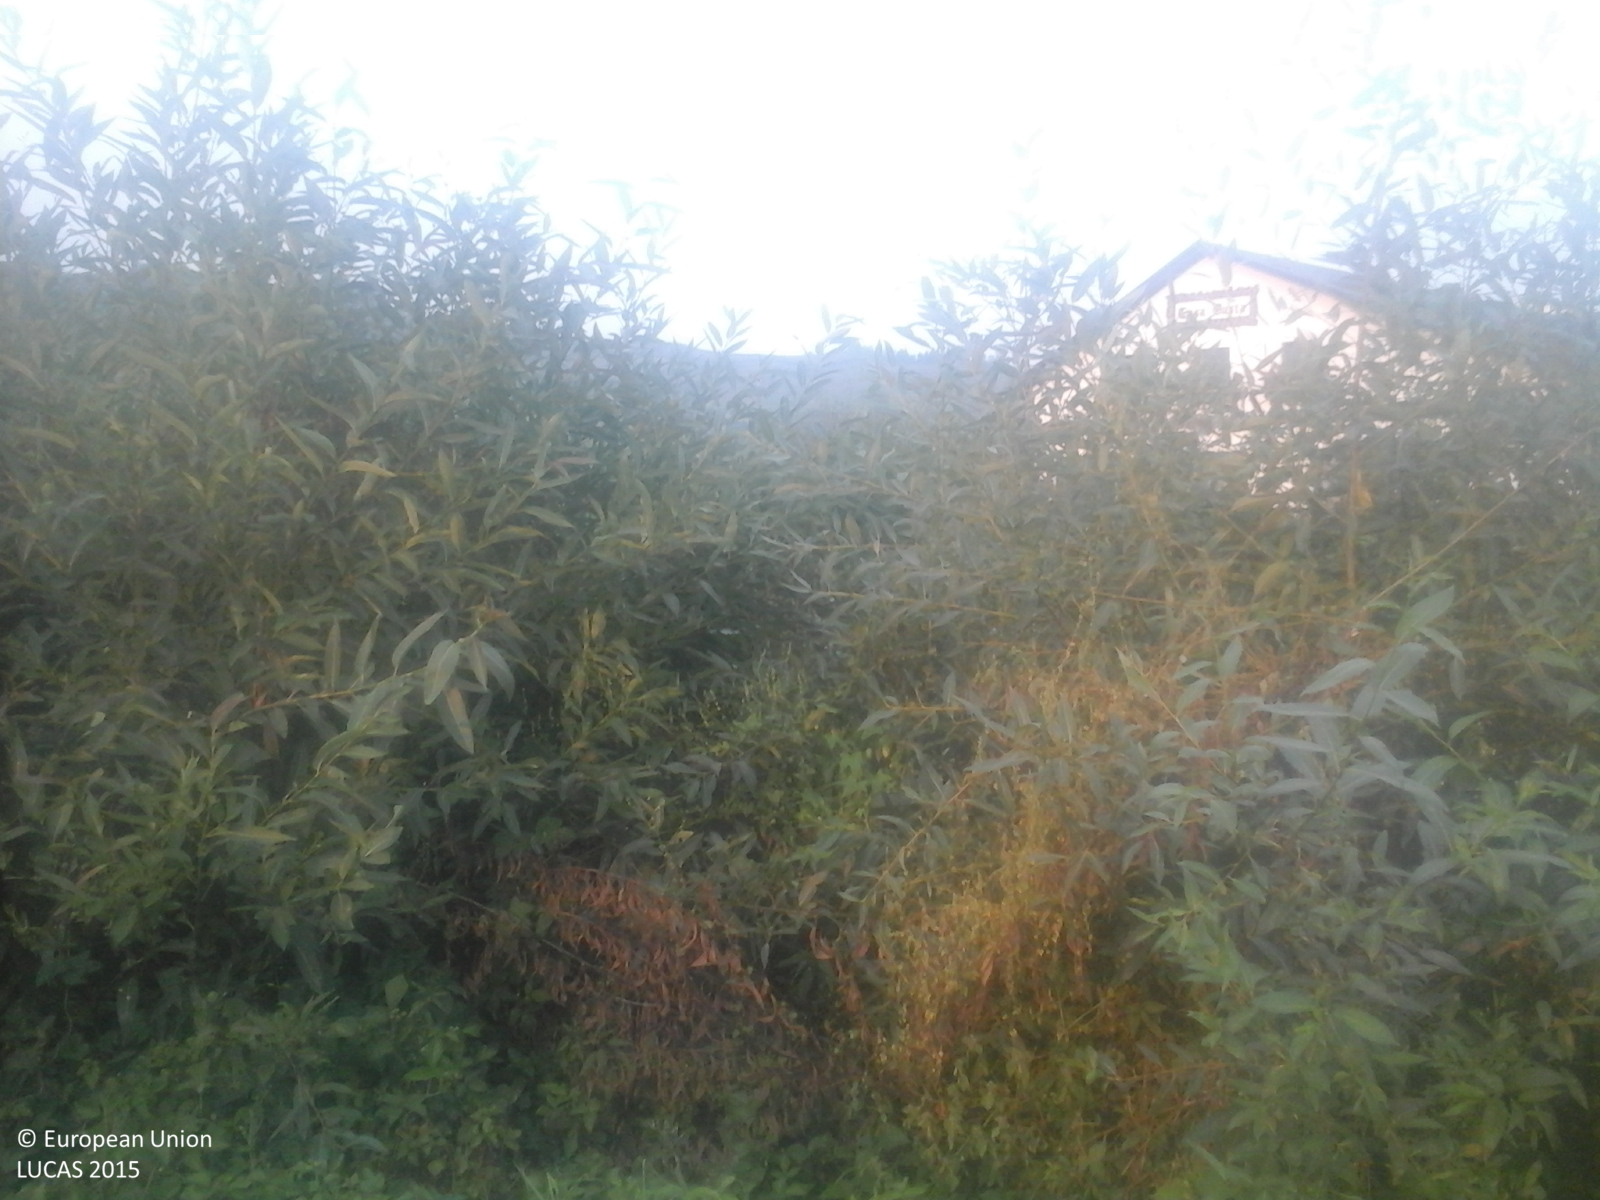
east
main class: Cropland
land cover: Lucerne
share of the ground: > 75 %
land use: Agriculture (excluding fallow land and kitchen gardens)
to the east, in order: Lucerne; Lines of trees; Fences; Grass margins; Tracks; Shrubland with sparse tree cover; Inland fresh running water; Shrubland with sparse tree cover; Artificial constructions in urban areas
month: September
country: RO
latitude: 47.6934
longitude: 24.2530
